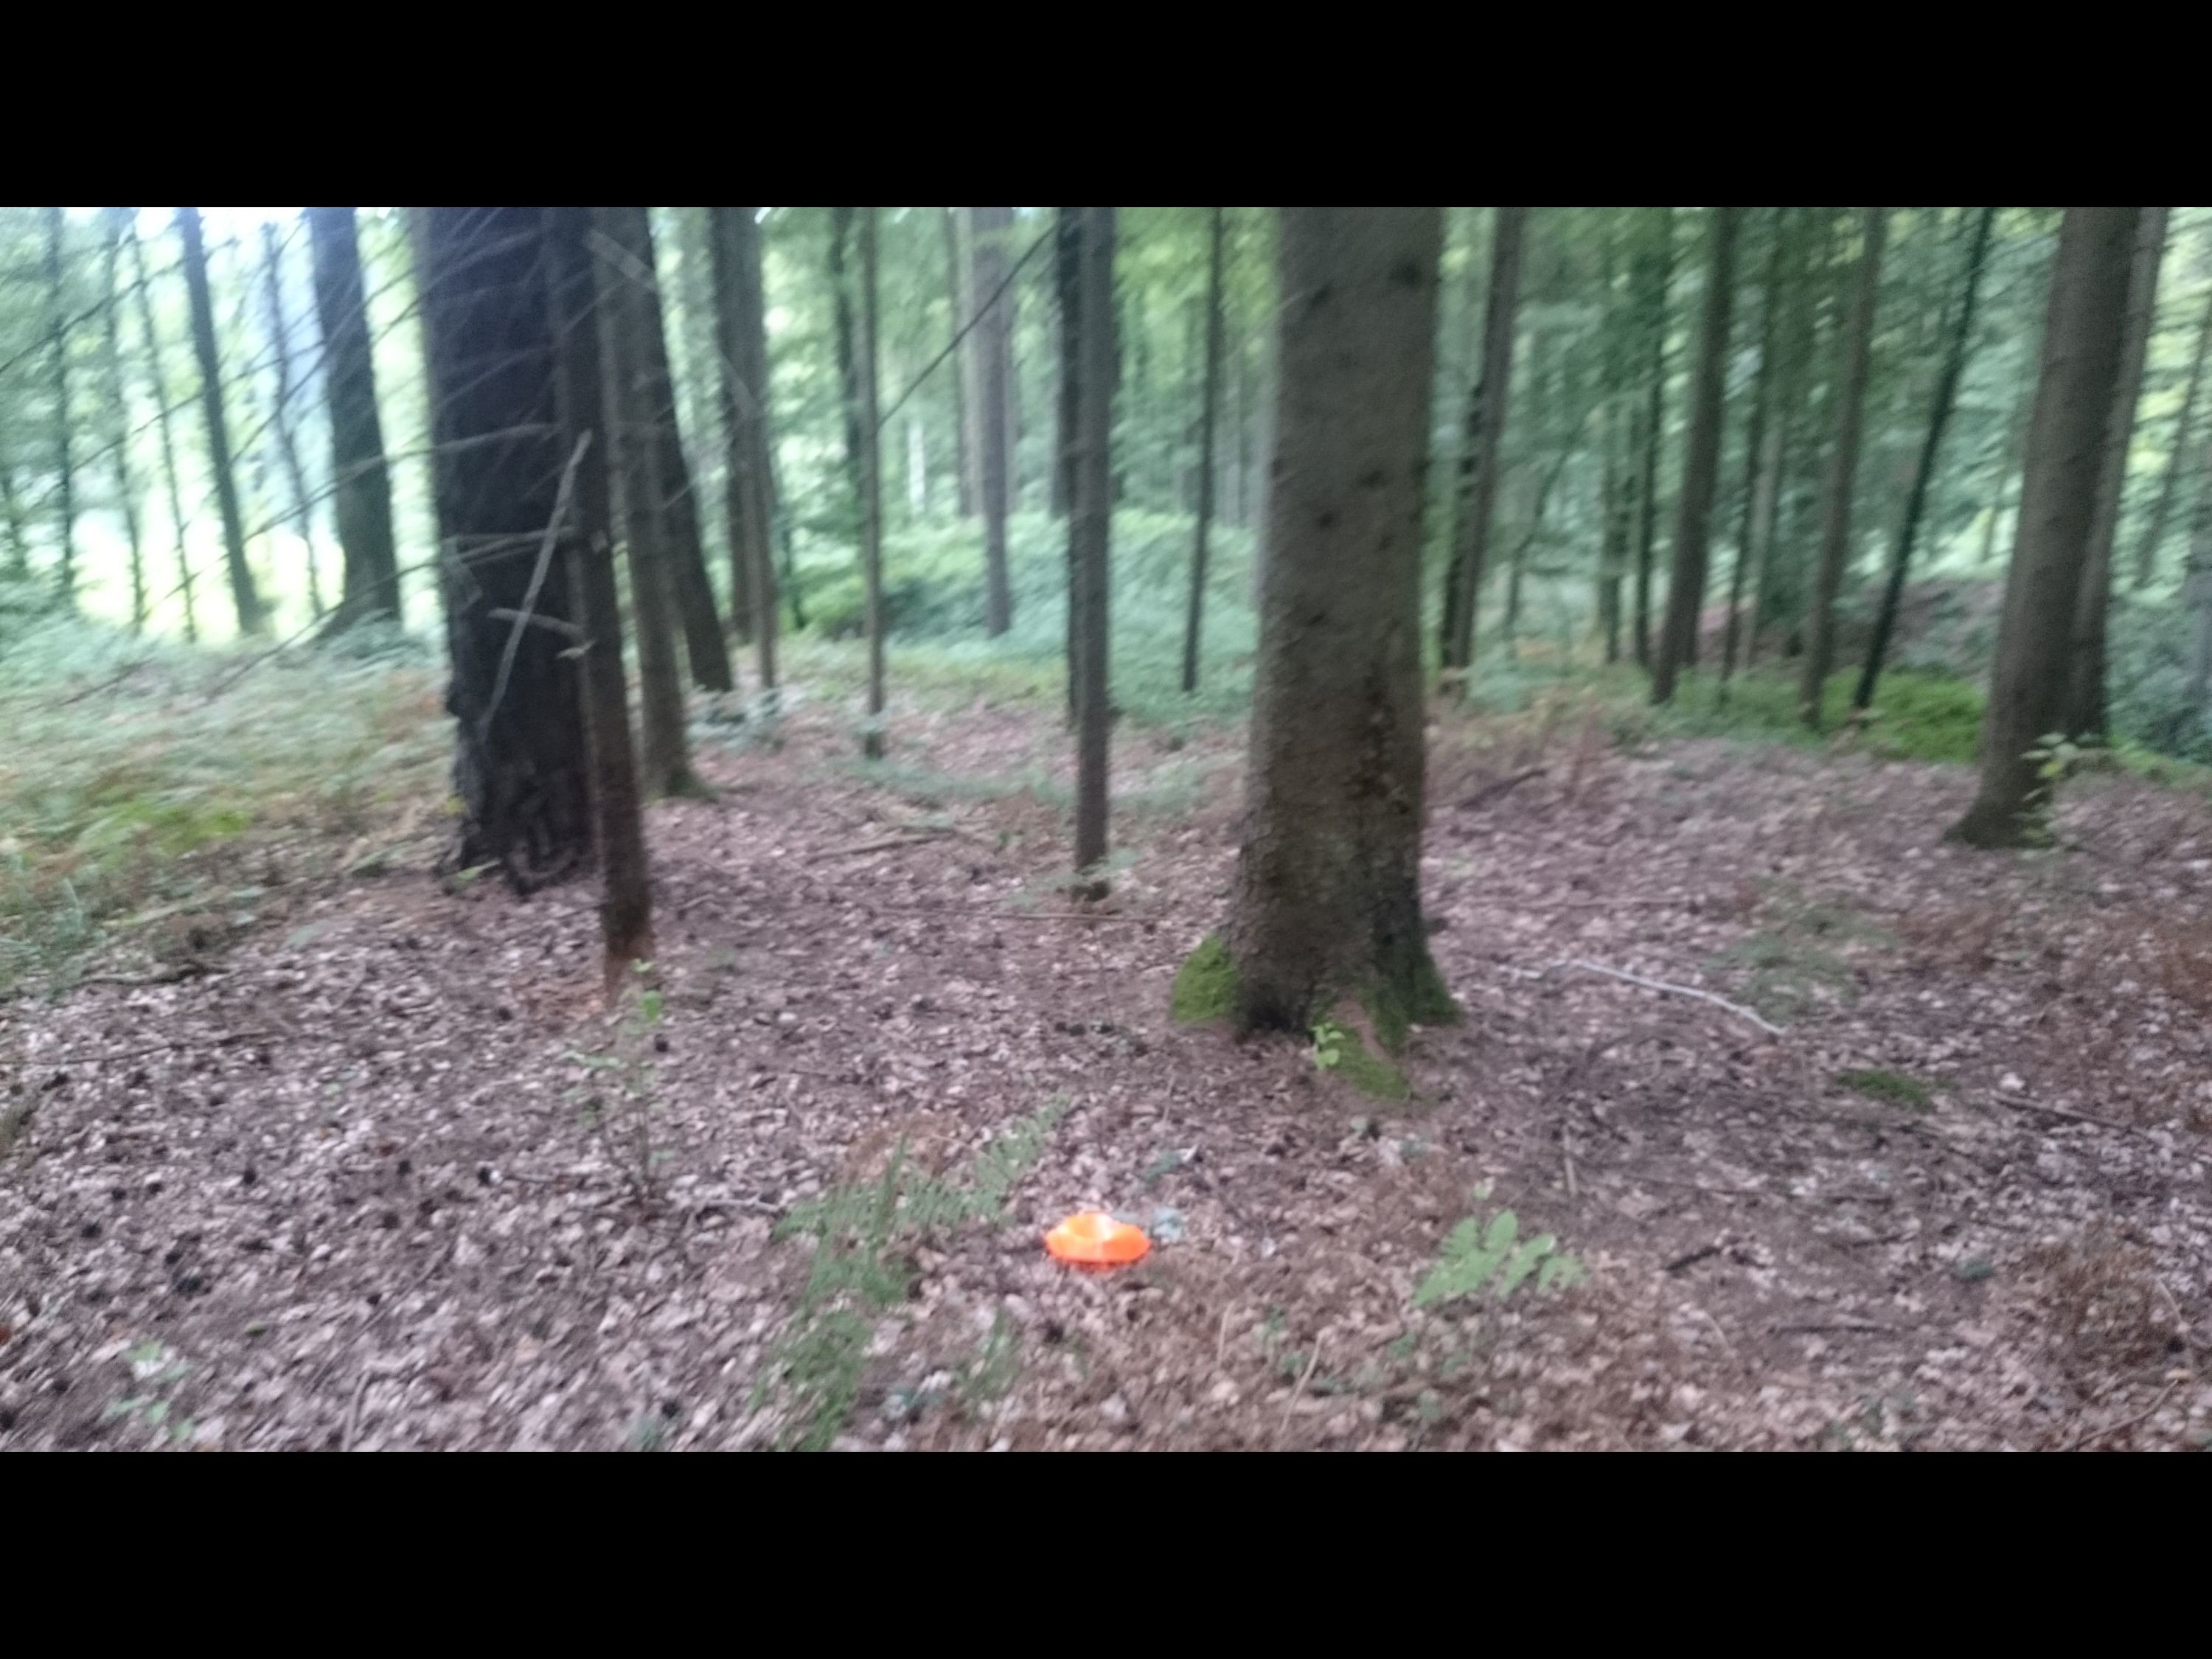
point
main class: Woodland
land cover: Other mixed woodland
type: hemiboreal forest and nemoral coniferous forest and mixed broadleaved-coniferous forest
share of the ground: > 75 %
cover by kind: coniferous forest trees 60 %, broadleaved forest trees 30 %, unconsolidated bare surface 10 %
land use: Forestry
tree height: > 5 m
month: July
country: AT
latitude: 46.9962
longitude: 15.9843
